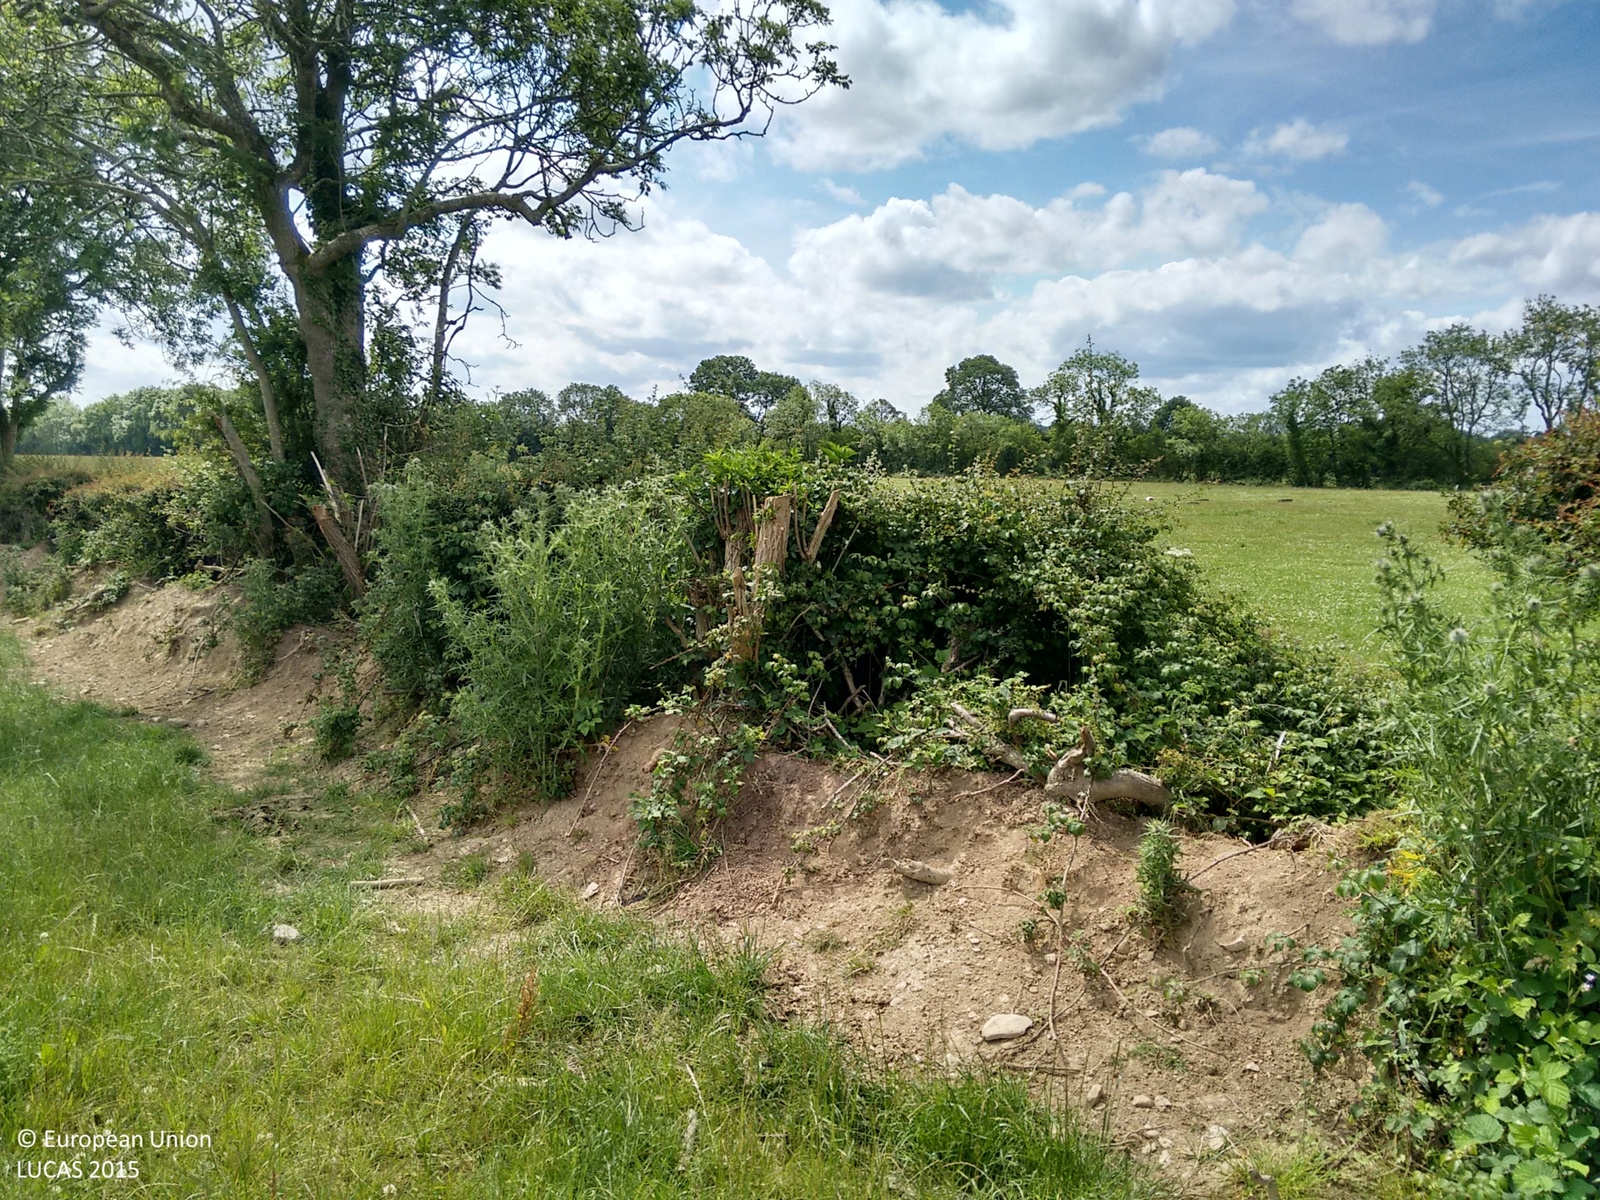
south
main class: Grassland
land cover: Grassland without tree/shrub cover
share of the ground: > 75 %
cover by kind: herbaceous plants 100 %
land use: Agriculture (excluding fallow land and kitchen gardens)
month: July
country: IE
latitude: 53.7991
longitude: -6.7901
